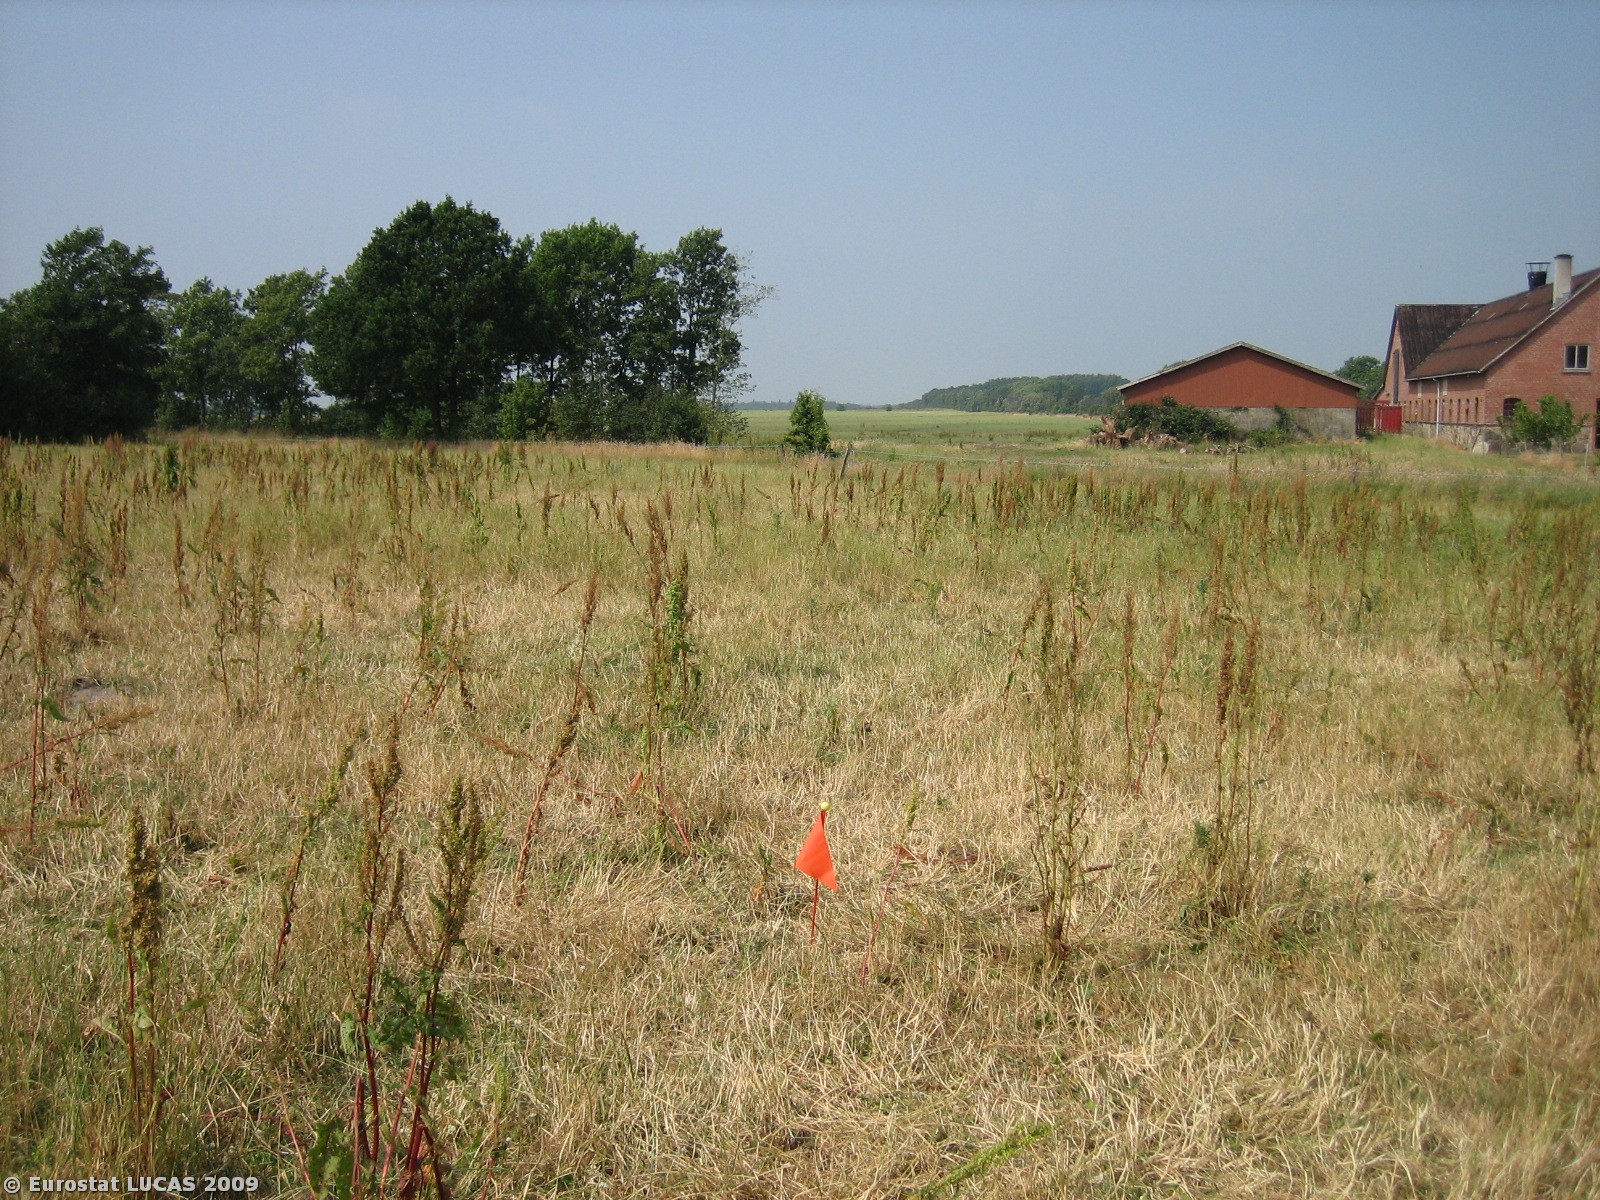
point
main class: Grassland
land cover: Grassland without tree/shrub cover
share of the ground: > 75 %
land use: Agriculture (excluding fallow land and kitchen gardens)
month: July
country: DK
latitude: 55.5710
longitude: 8.8117
